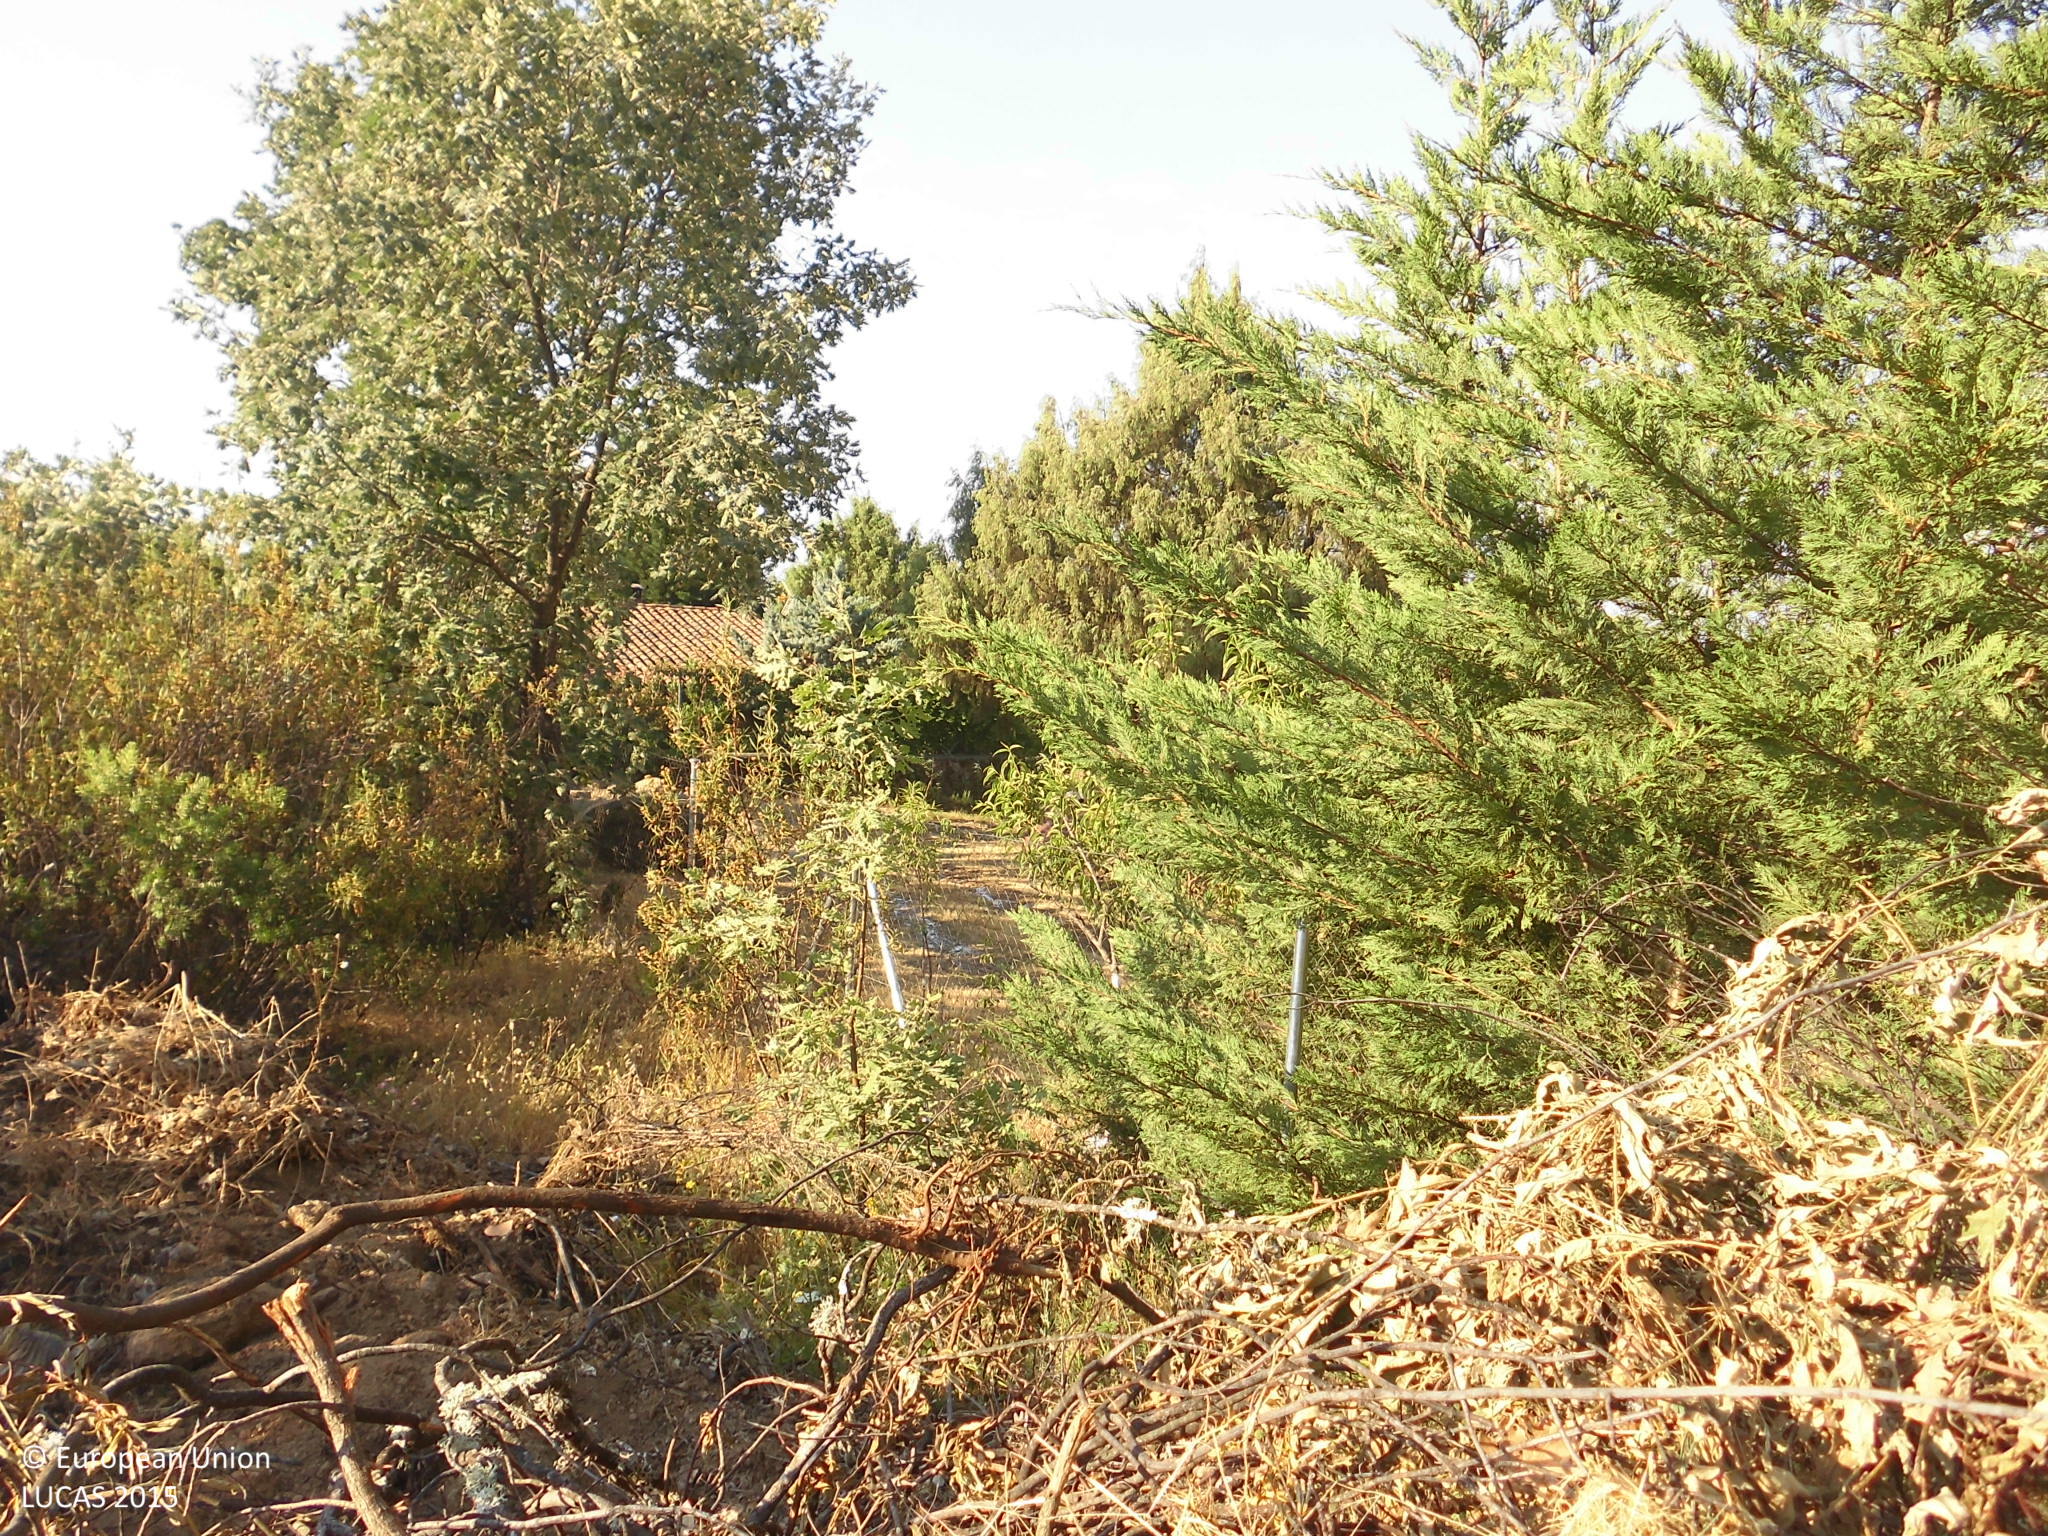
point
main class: Shrubland
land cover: Shrubland with sparse tree cover
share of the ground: > 75 %
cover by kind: shrubs 75 %, herbaceous plants 20 %, broadleaved forest trees 5 %
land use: Residential
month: June
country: ES
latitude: 40.1383
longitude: -5.4481
